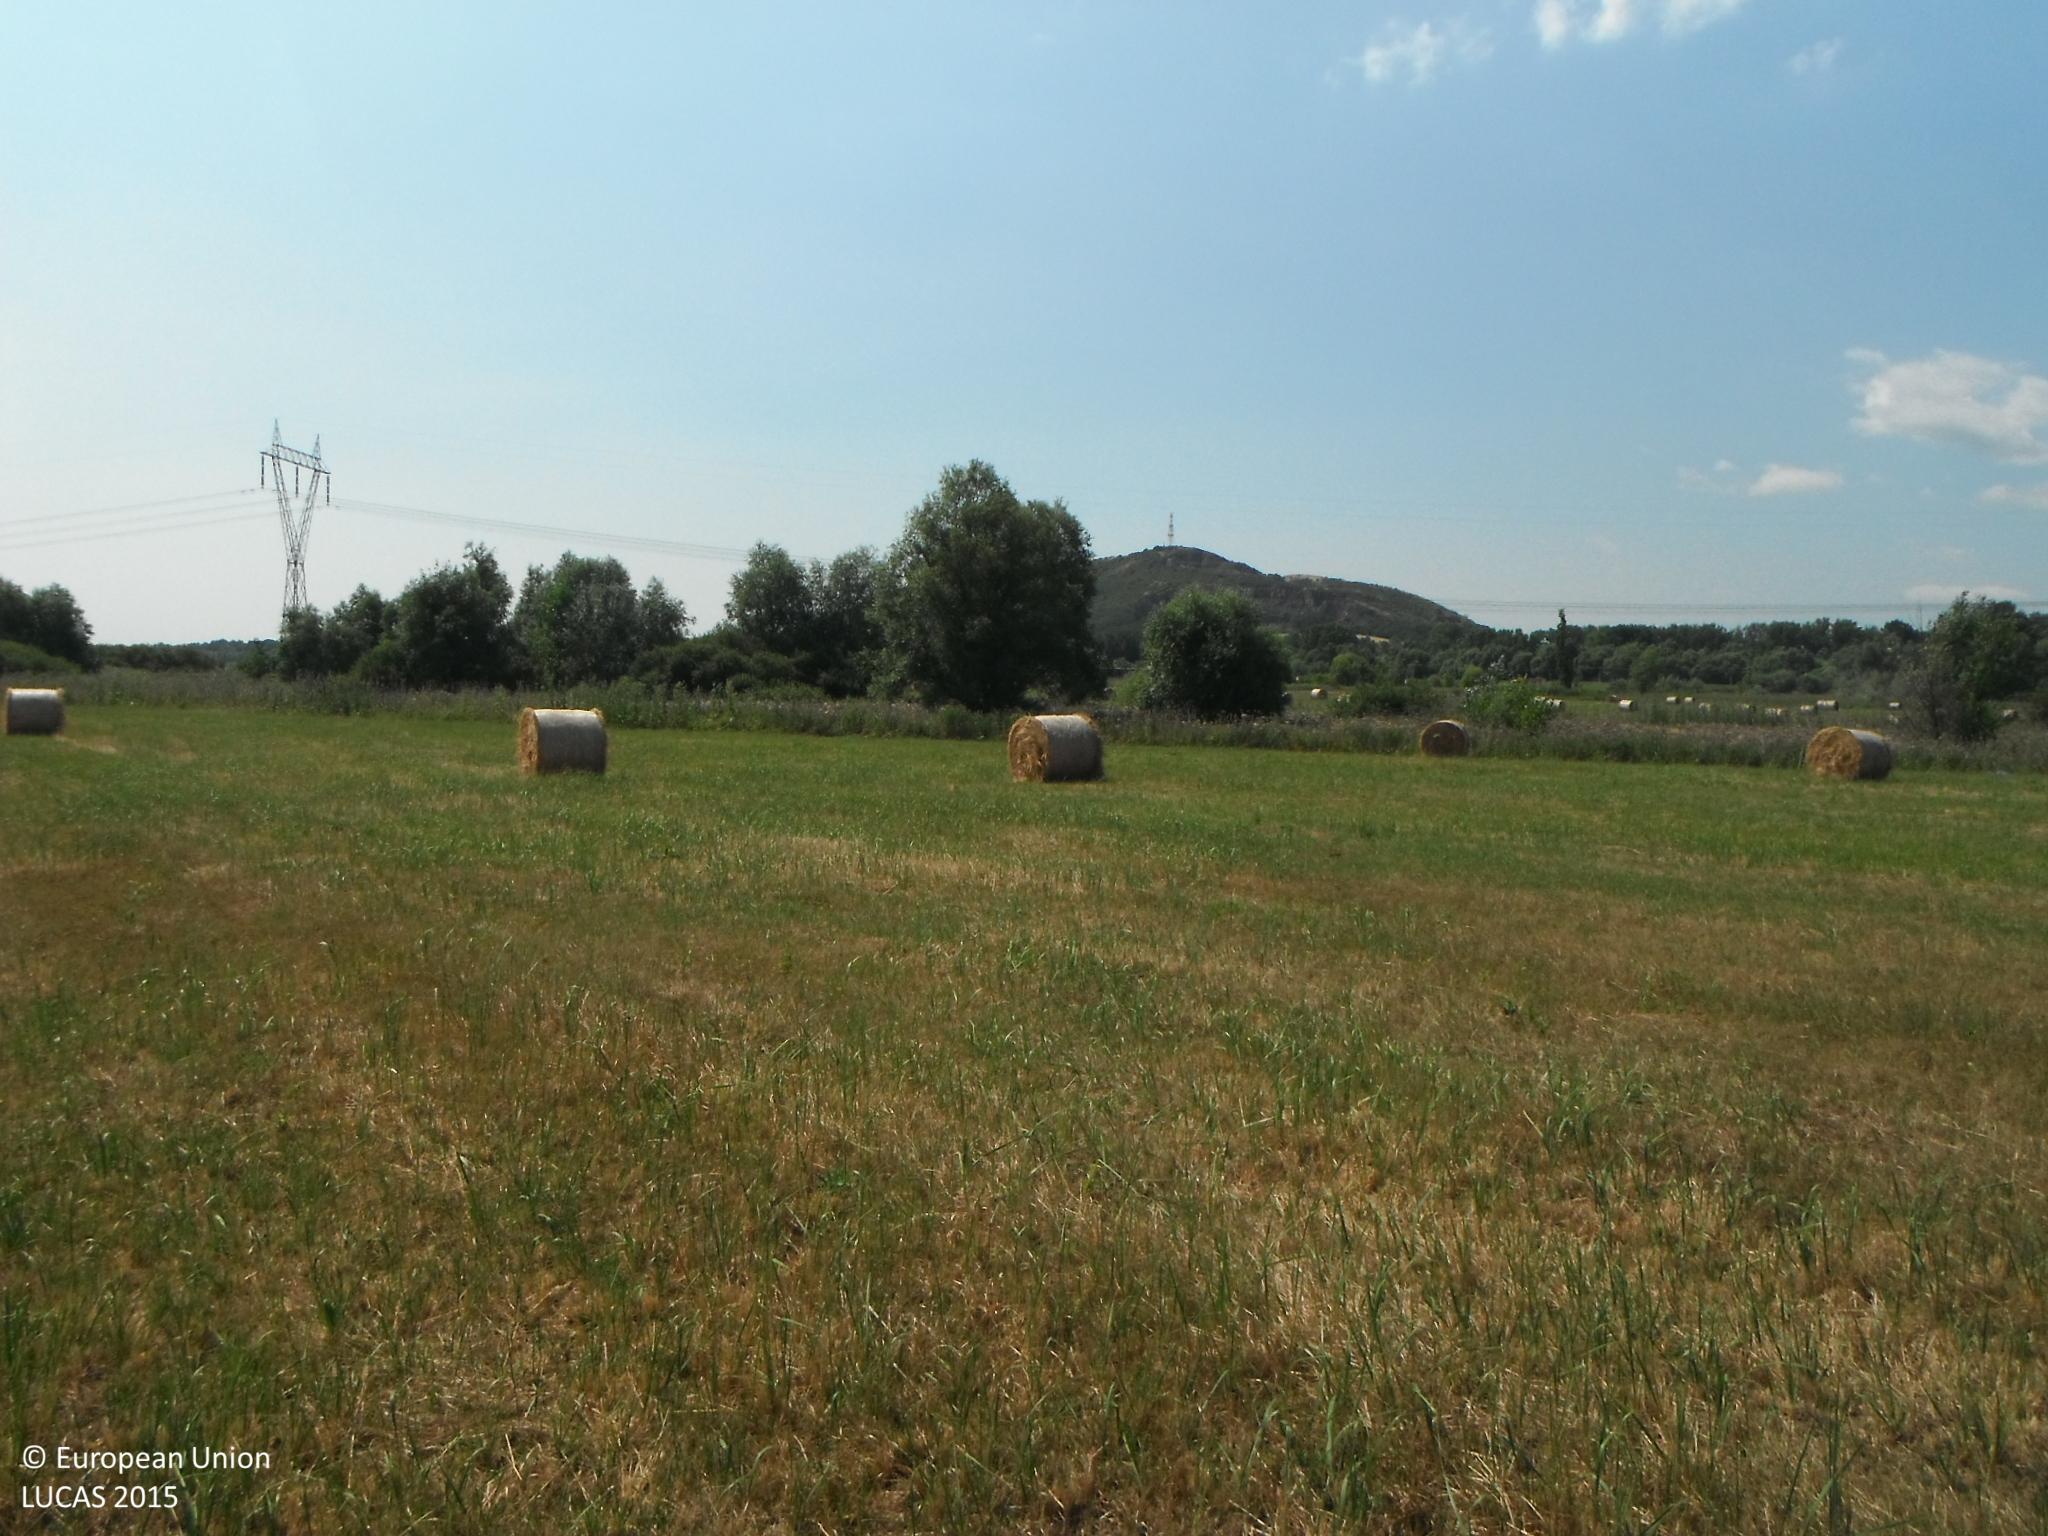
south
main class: Grassland
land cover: Grassland without tree/shrub cover
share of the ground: > 75 %
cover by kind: herbaceous plants 100 %
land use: Agriculture (excluding fallow land and kitchen gardens)
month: July
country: SK
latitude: 48.5130
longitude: 21.8152
